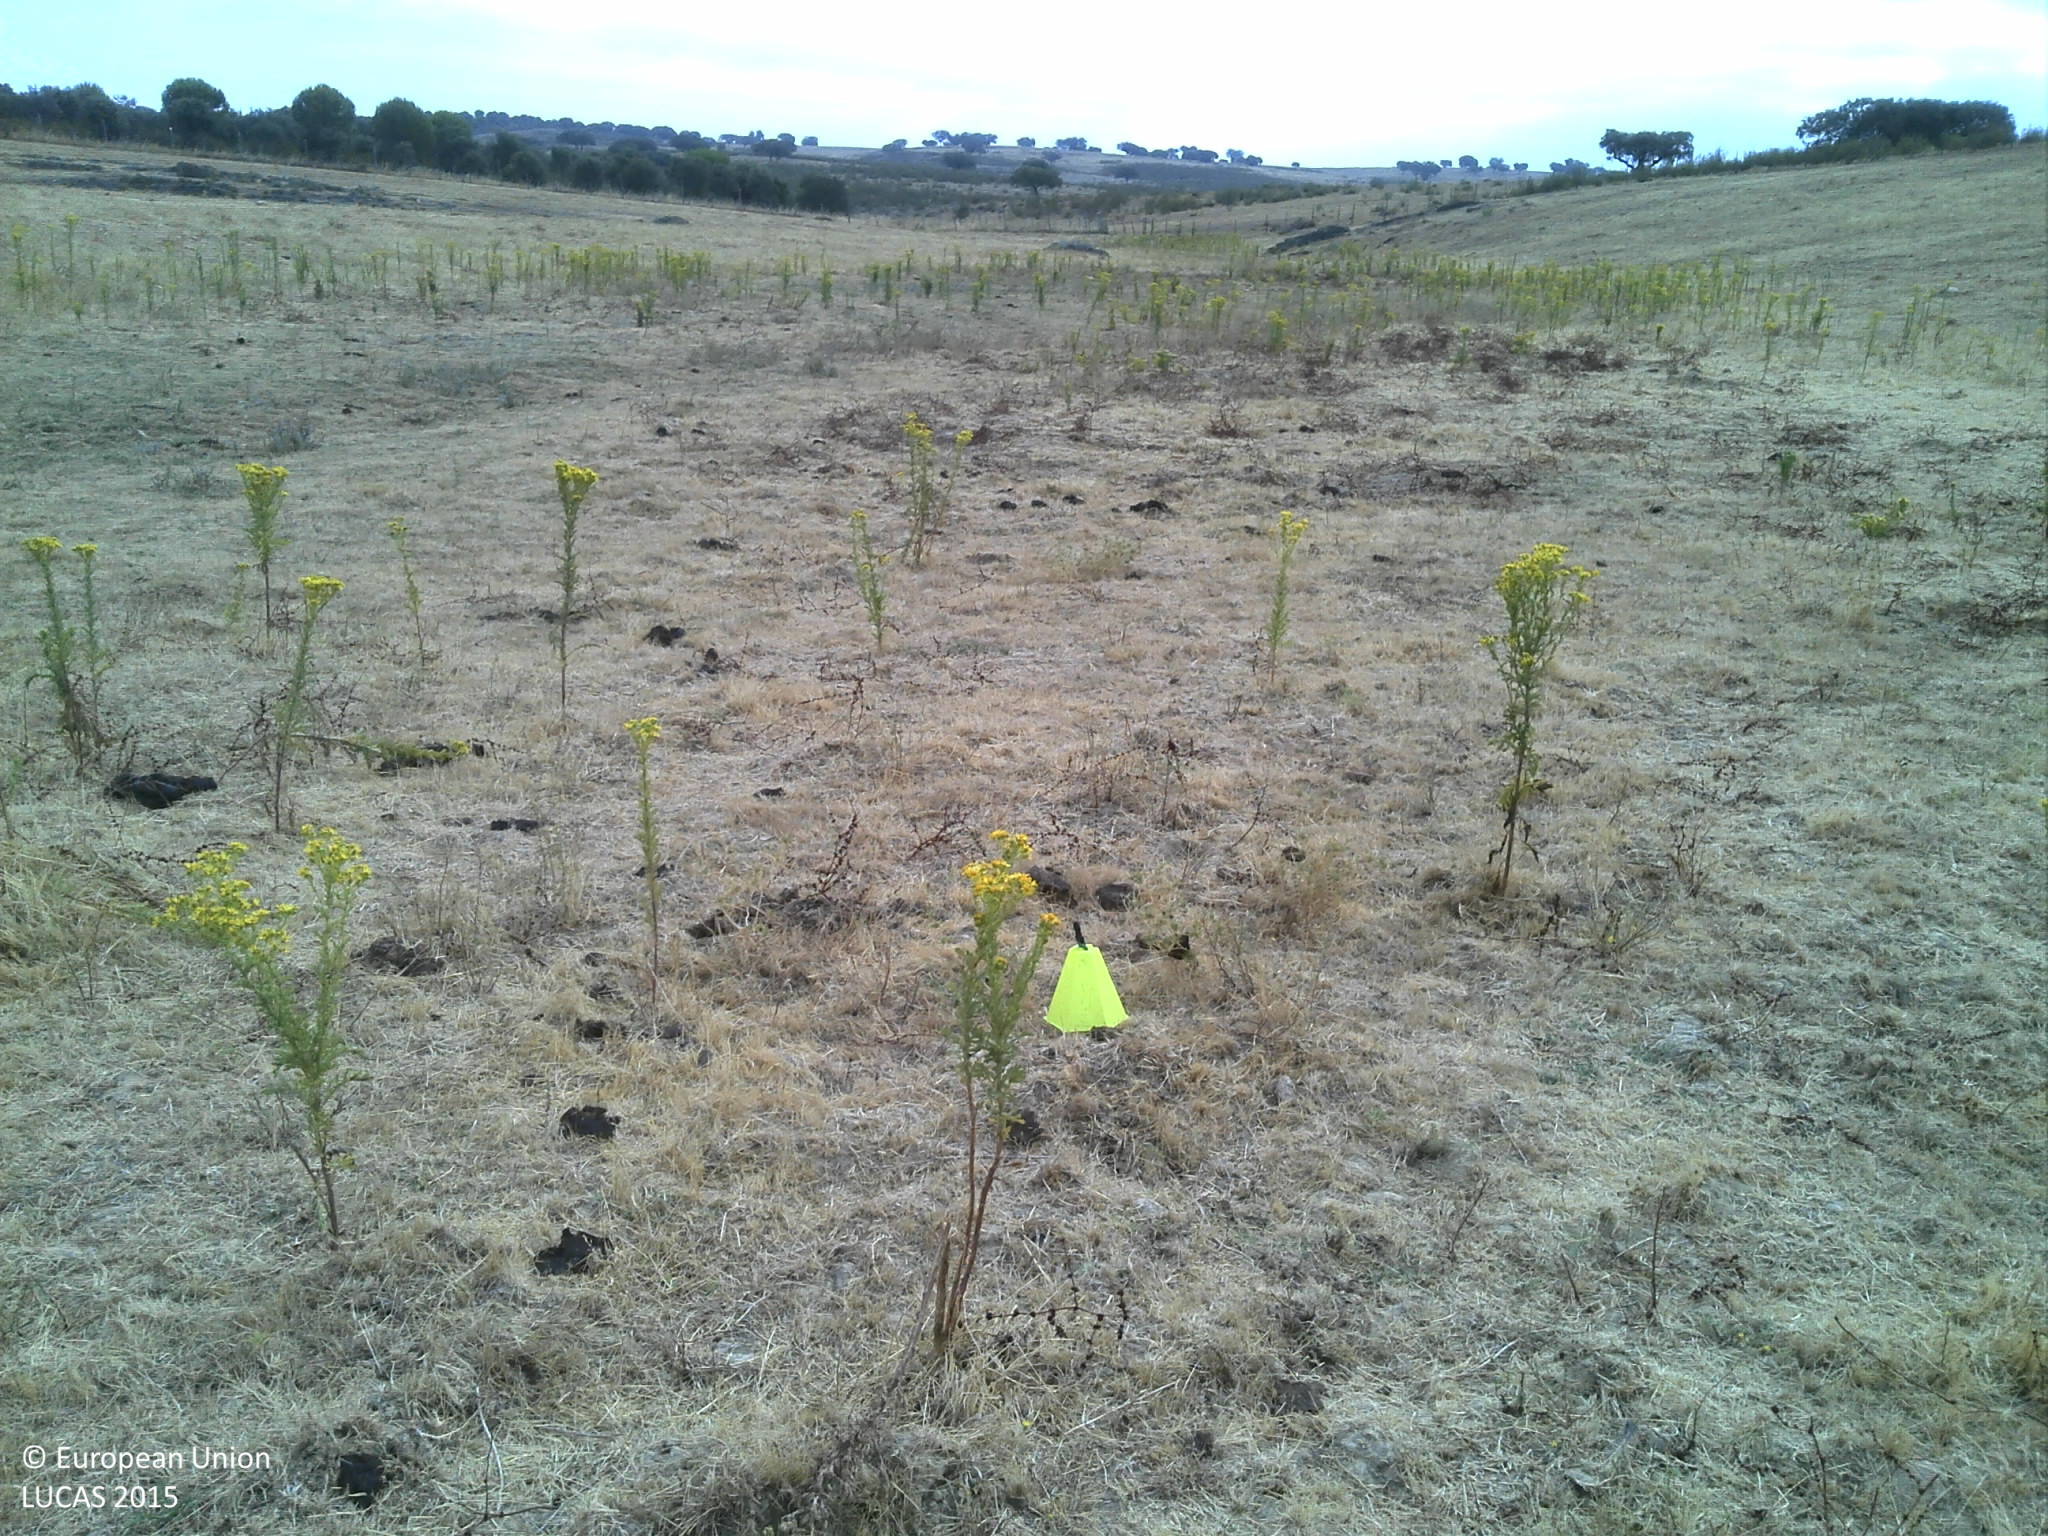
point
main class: Grassland
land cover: Grassland without tree/shrub cover
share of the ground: 25 - 50 %
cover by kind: unconsolidated bare surface 75 %, herbaceous plants 25 %
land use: Agriculture (excluding fallow land and kitchen gardens)
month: July
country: PT
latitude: 38.4829
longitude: -7.3698
